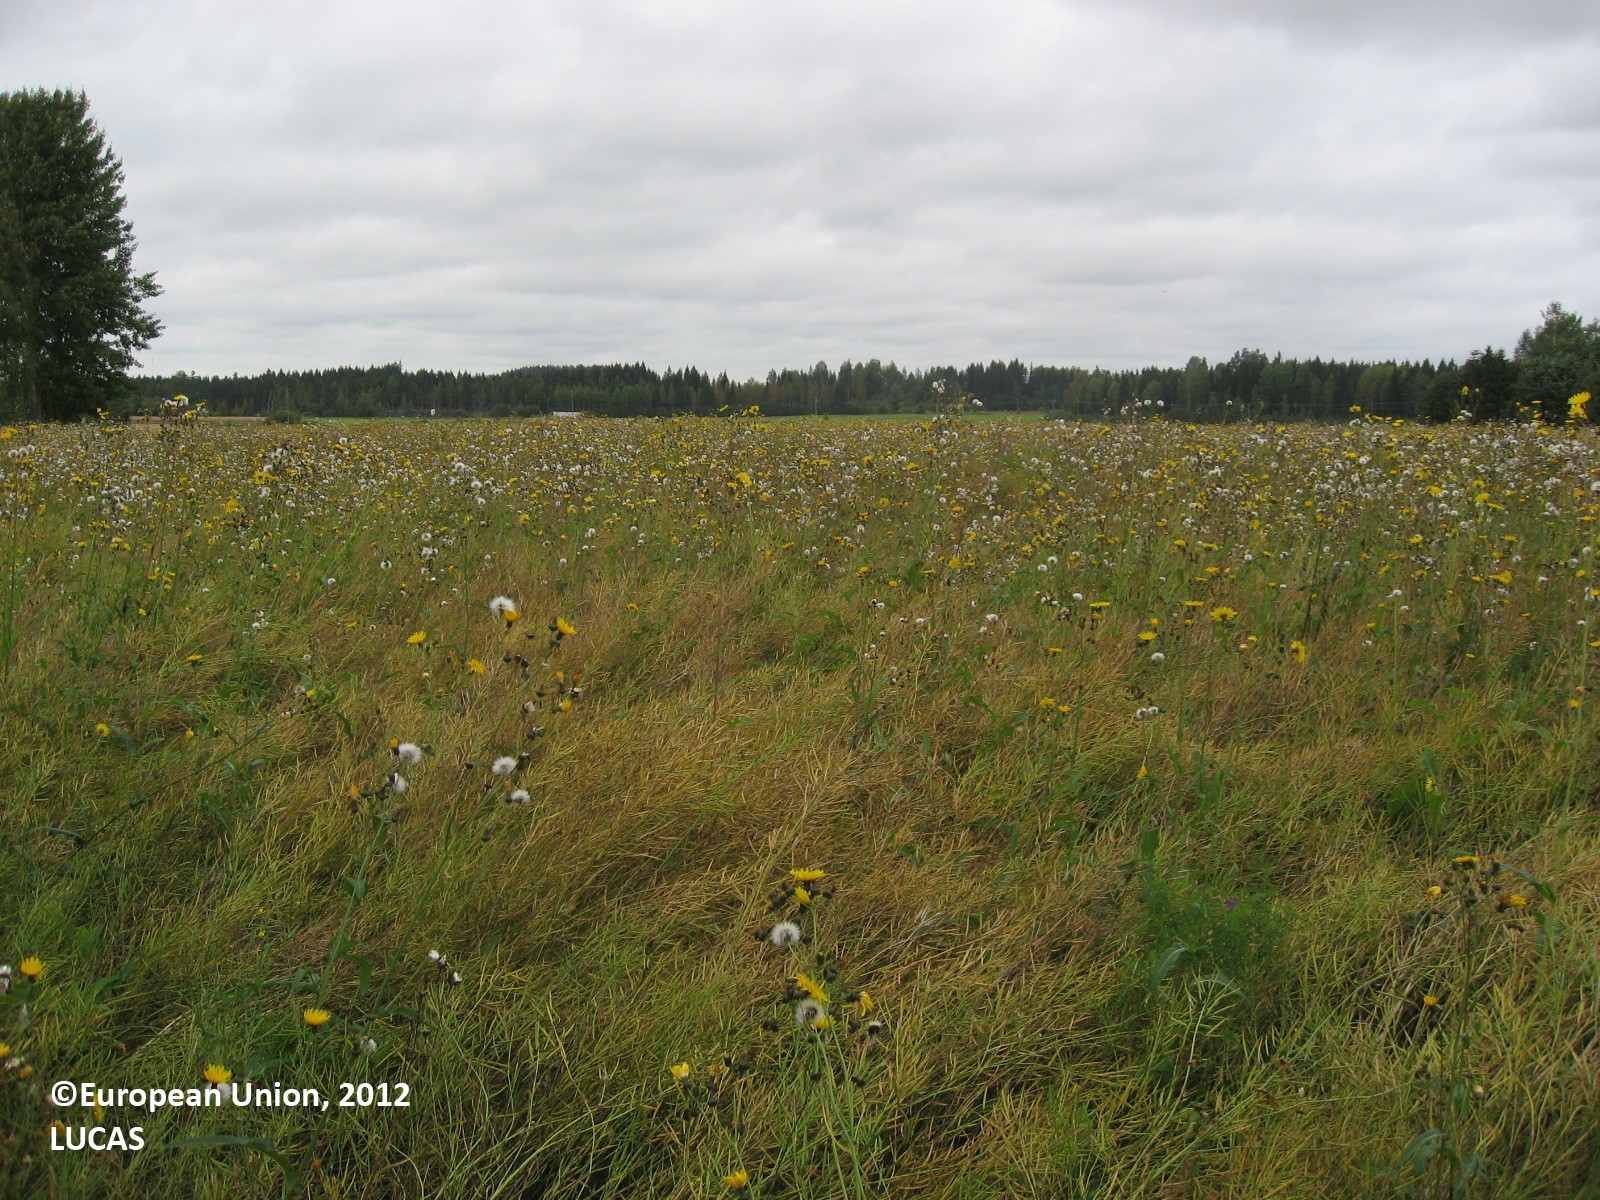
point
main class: Cropland
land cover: Rape and turnip rape
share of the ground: 50 - 75 %
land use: Agriculture (excluding fallow land and kitchen gardens)
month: August
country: FI
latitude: 60.9343
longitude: 25.3457
